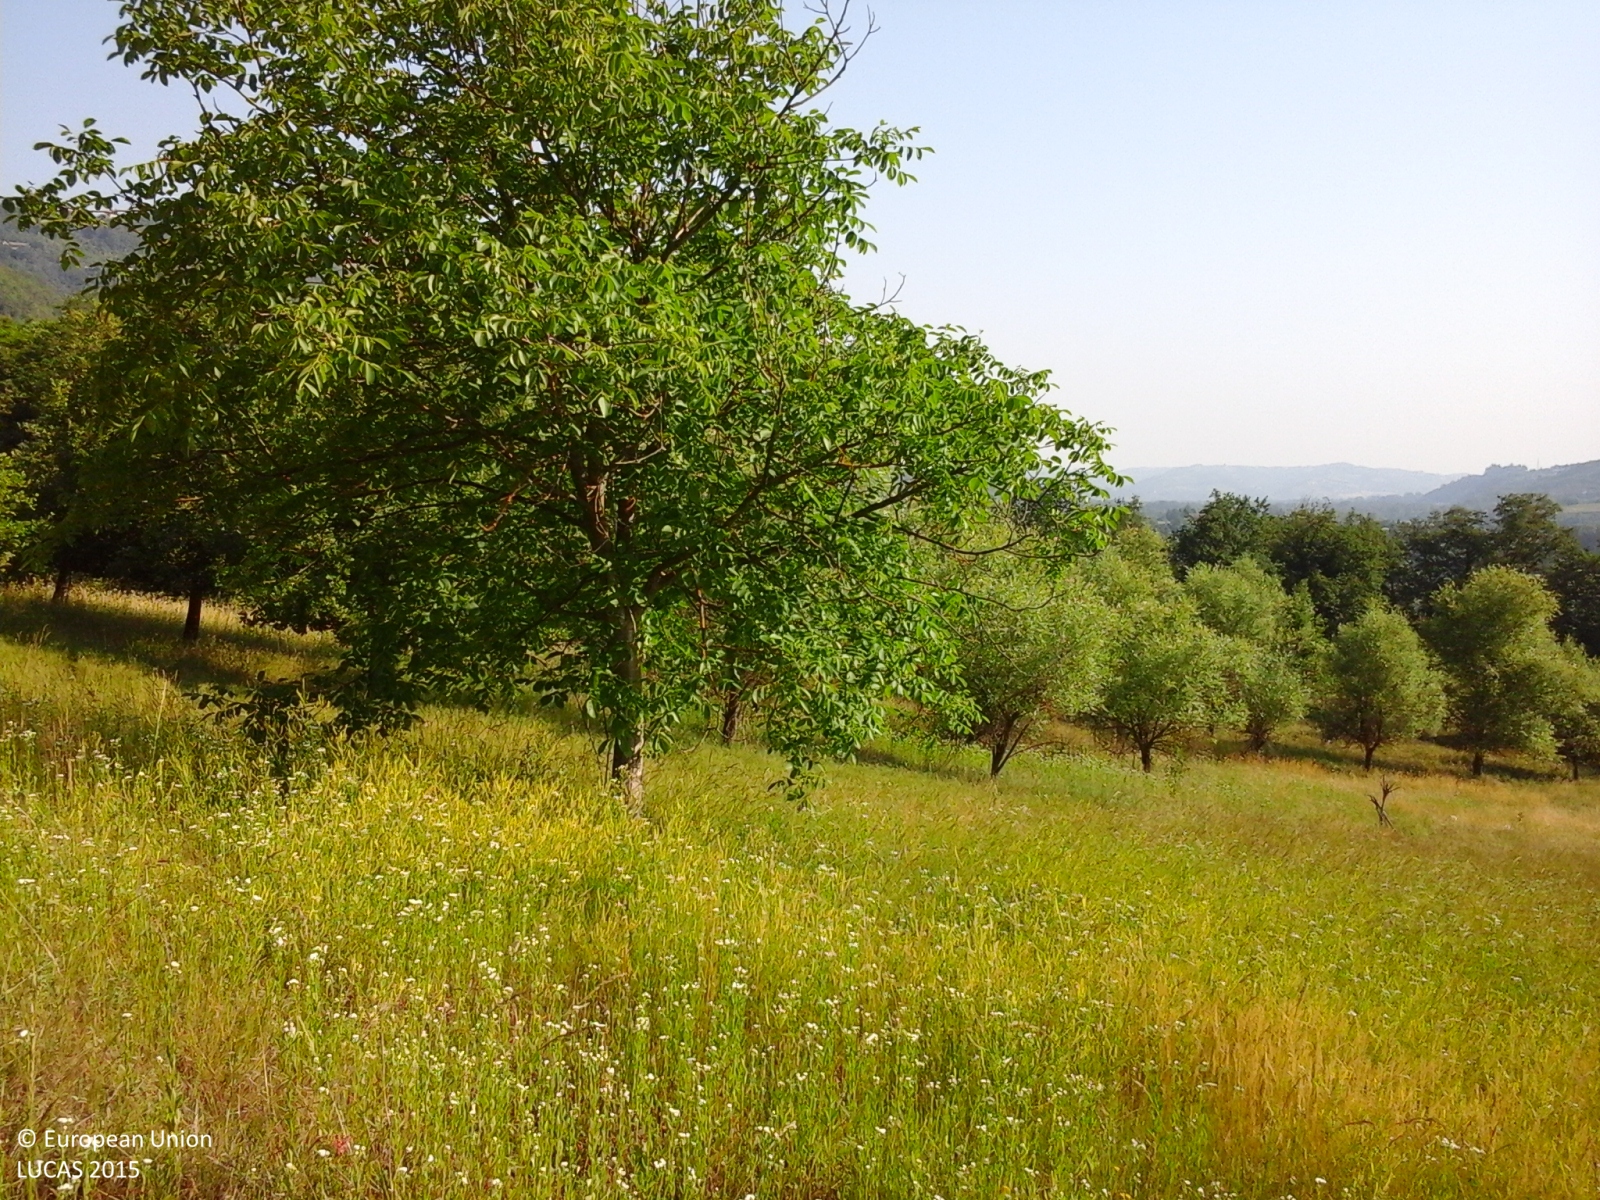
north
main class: Grassland
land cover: Grassland with sparse tree/shrub cover
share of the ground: > 75 %
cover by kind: herbaceous plants 90 %, broadleaved forest trees 5 %, shrubs 5 %
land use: Agriculture (excluding fallow land and kitchen gardens)
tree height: < 5 m
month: June
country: IT
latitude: 44.6088
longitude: 8.4031
